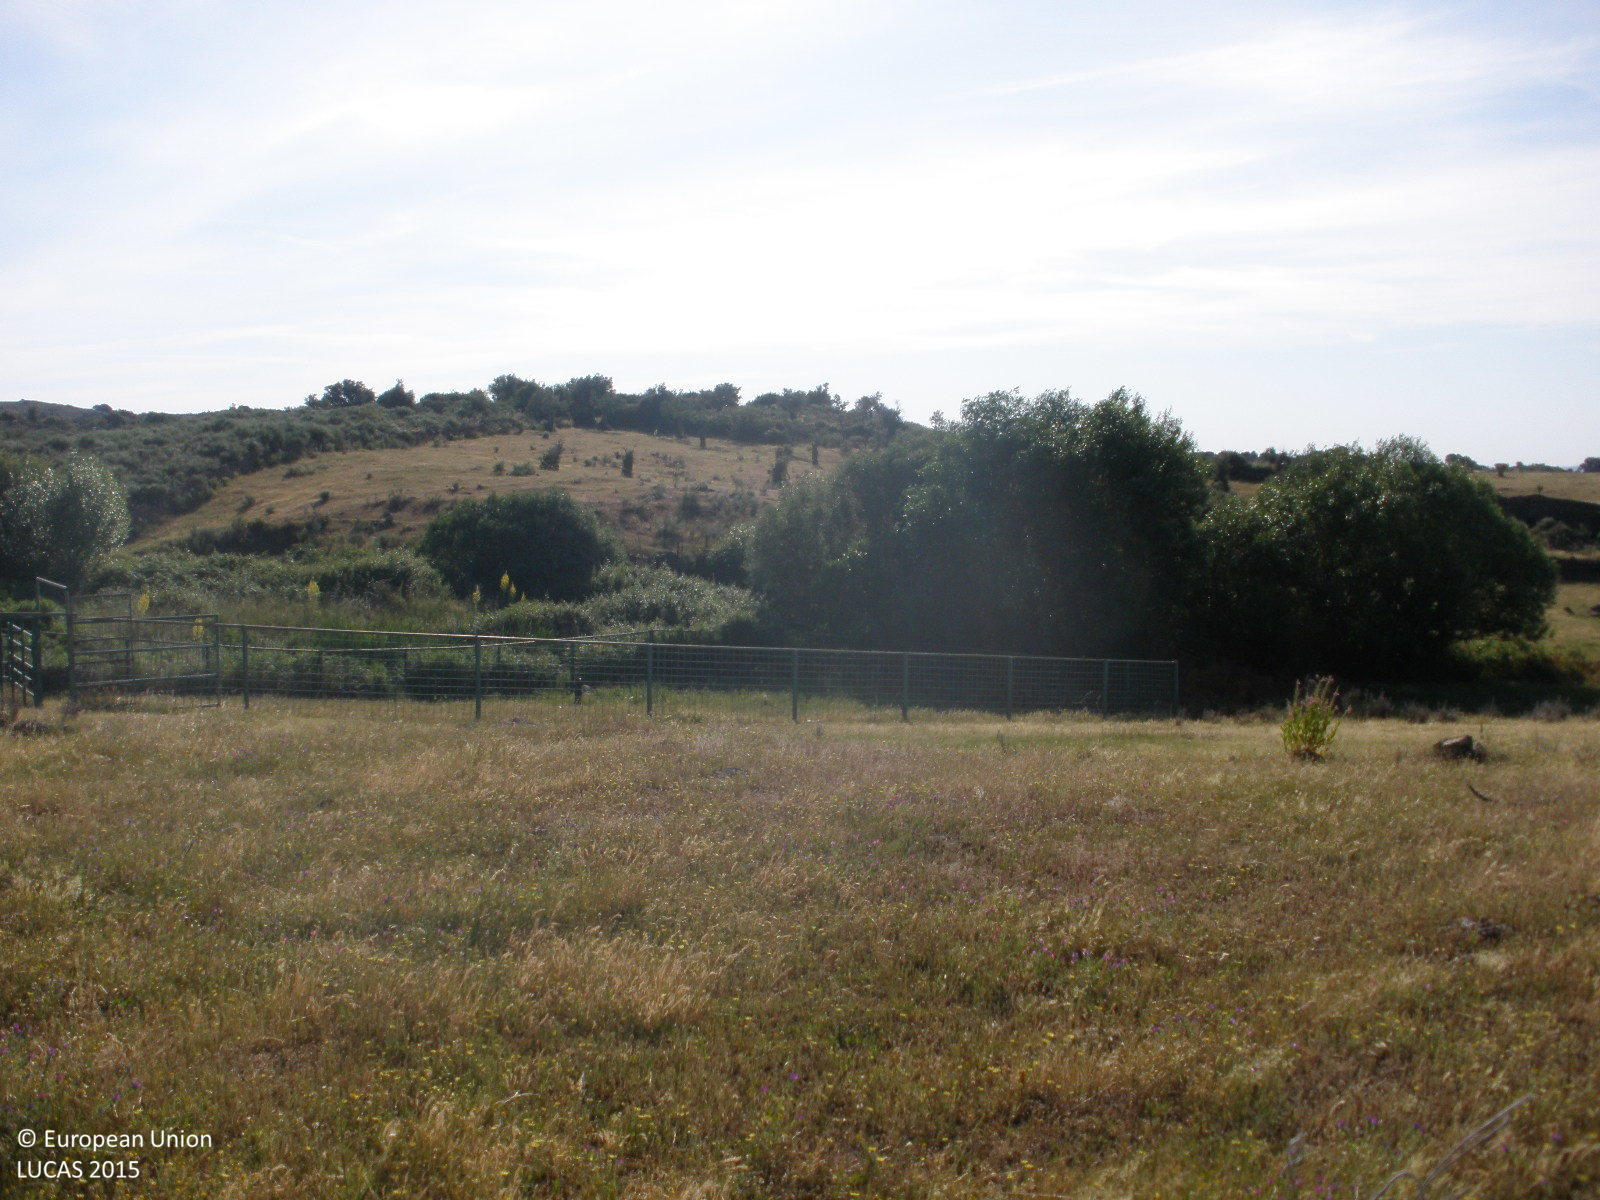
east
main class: Grassland
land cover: Grassland without tree/shrub cover
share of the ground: > 75 %
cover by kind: herbaceous plants 100 %
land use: Agriculture (excluding fallow land and kitchen gardens)
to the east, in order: Grassland without tree/shrub cover; Tracks; Grassland without tree/shrub cover; Dry stone walls; Grassland with sparse tree/shrub cover; Dry stone walls; Broadleaved woodland
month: May
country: ES
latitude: 40.1046
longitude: -6.7568
